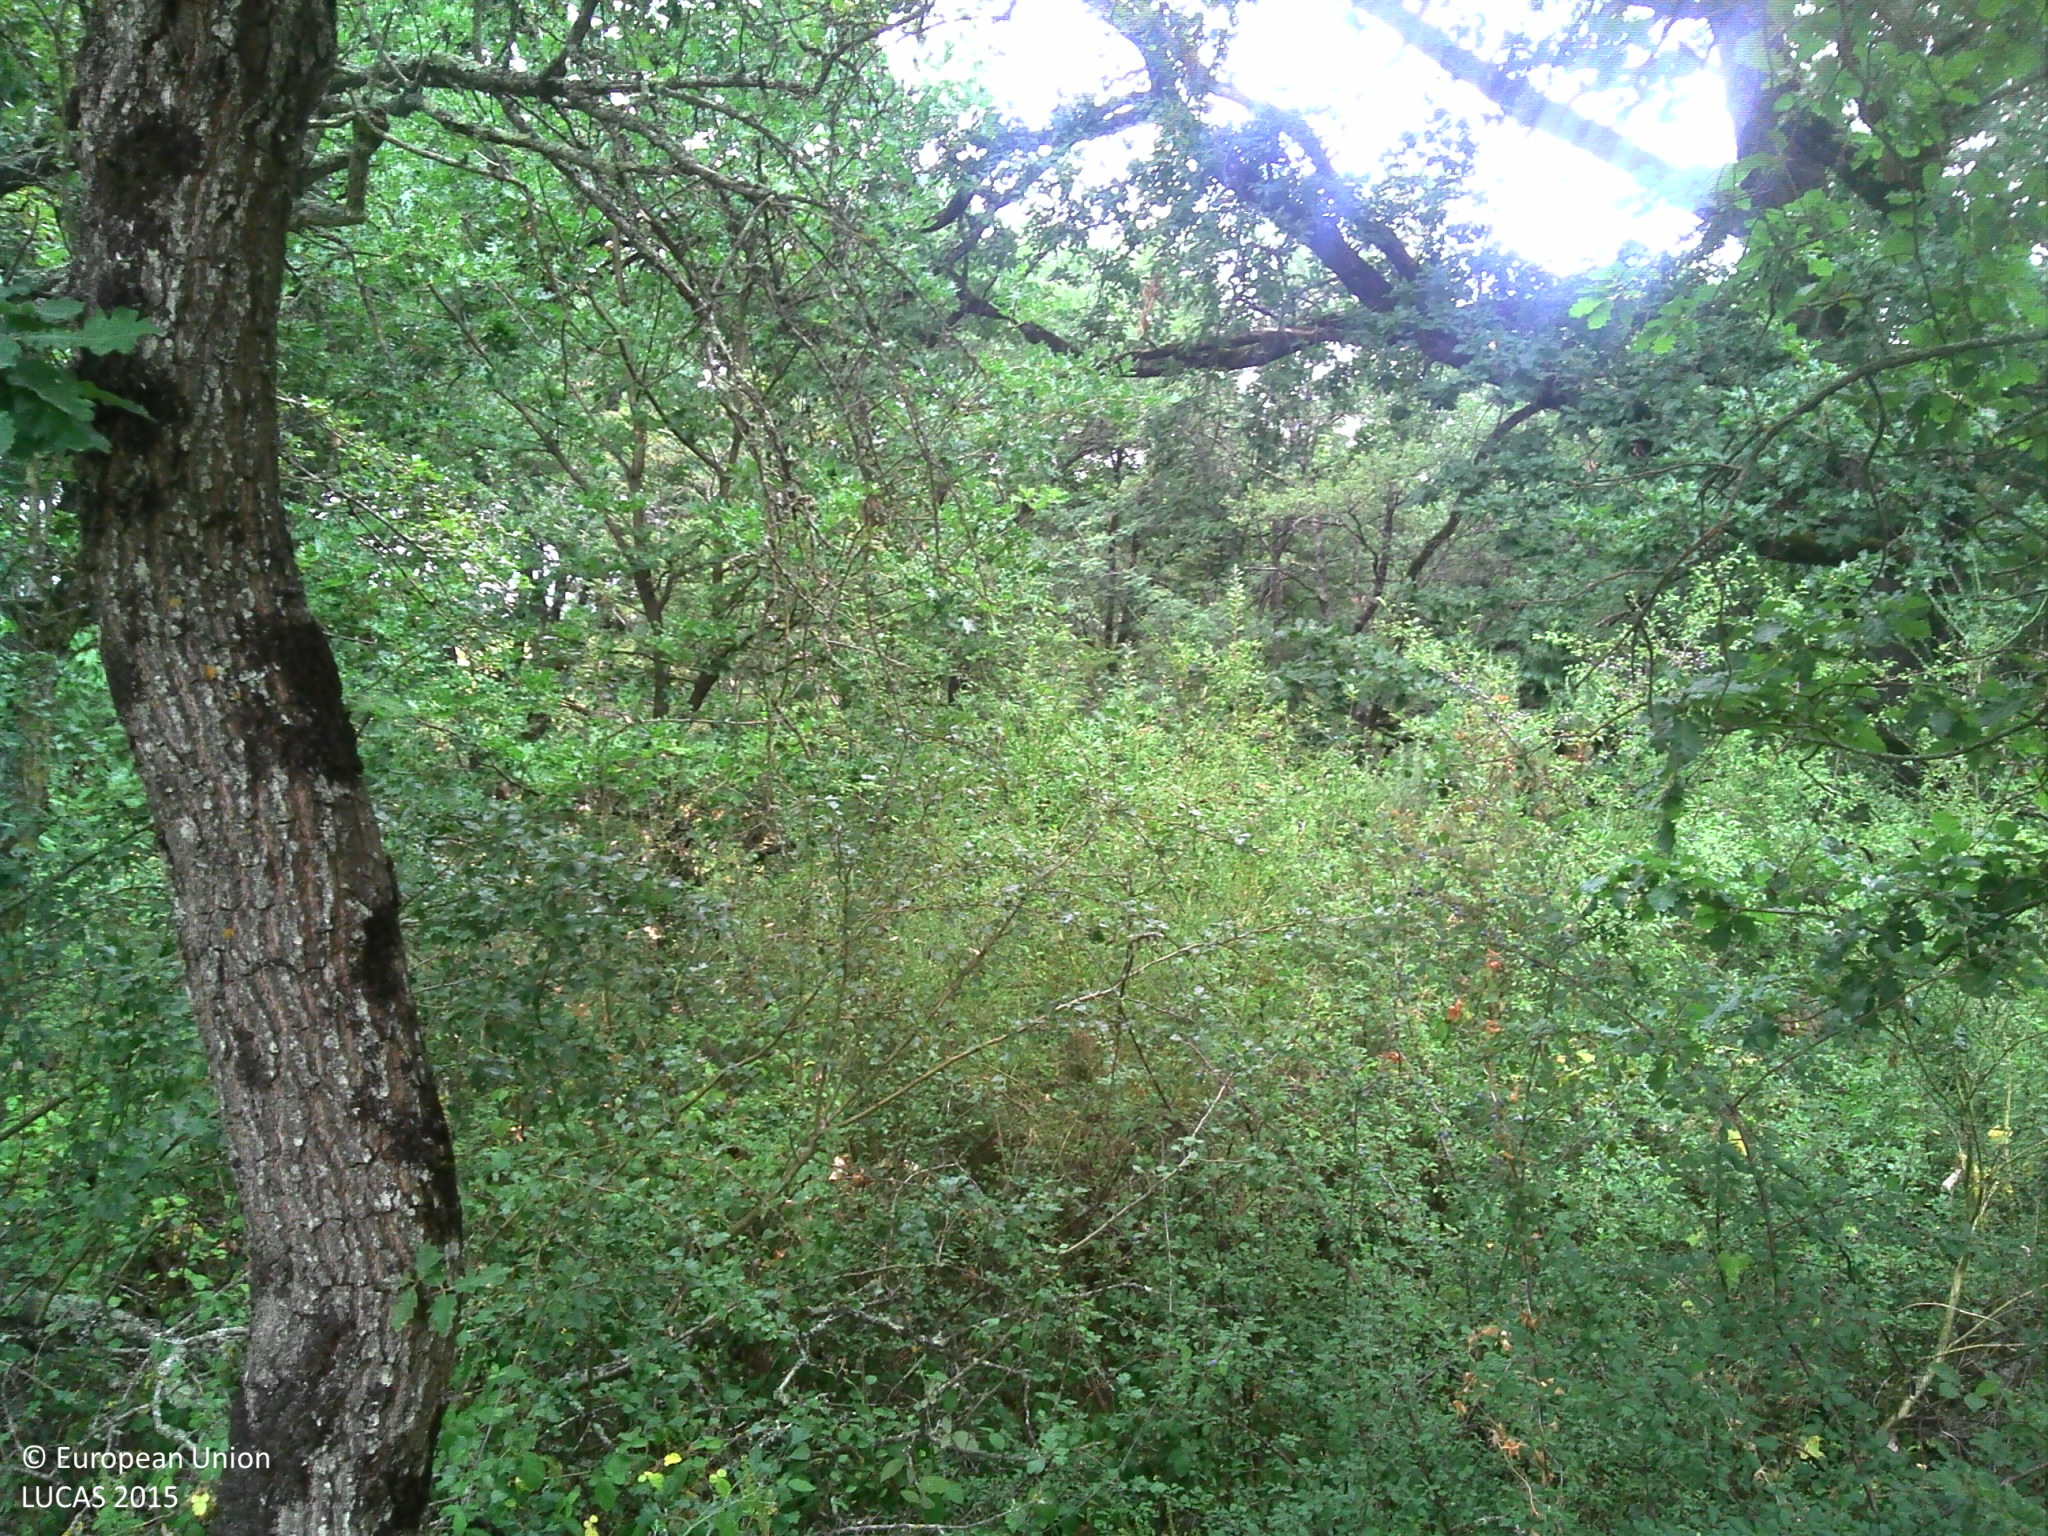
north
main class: Woodland
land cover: Broadleaved woodland
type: mesophytic deciduous forest
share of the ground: > 75 %
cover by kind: broadleaved forest trees 100 %
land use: Forestry
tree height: > 5 m
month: July
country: FR
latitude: 43.9713
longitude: 0.9359
